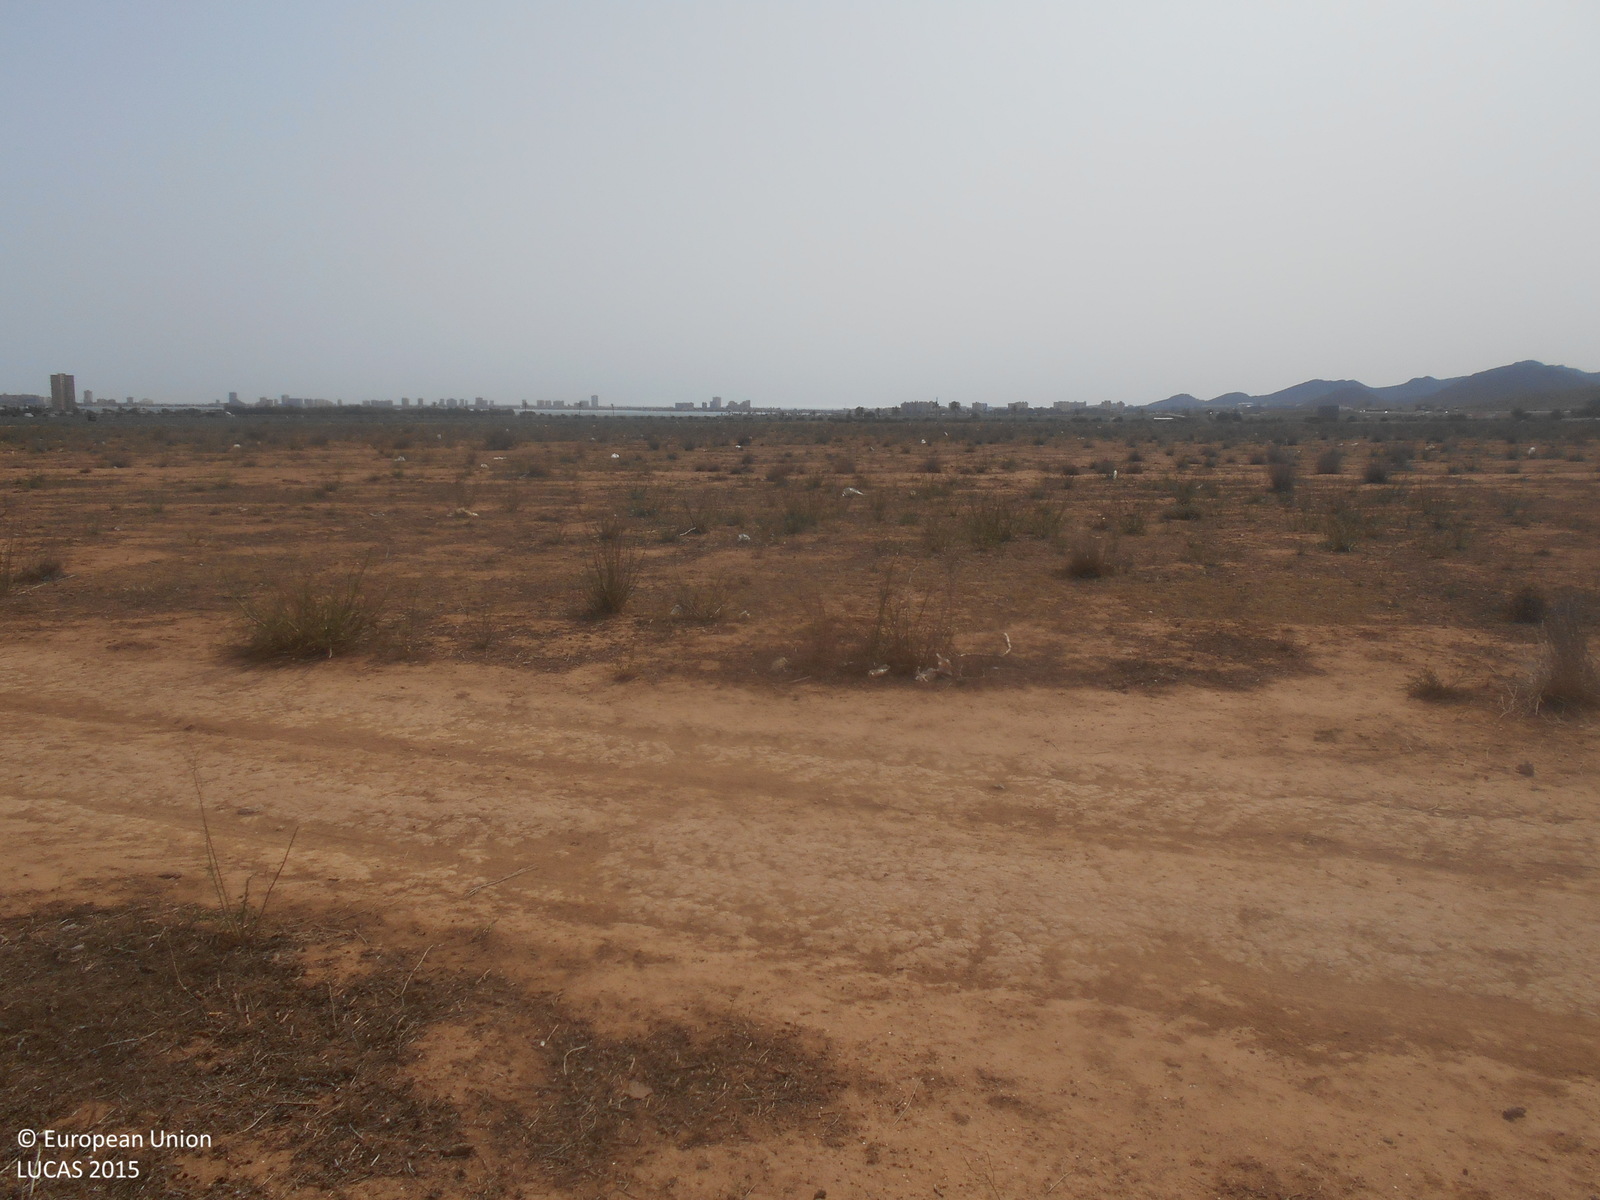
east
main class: Shrubland
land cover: Shrubland without tree cover
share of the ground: 10 - 25 %
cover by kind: unconsolidated bare surface 80 %, shrubs 10 %, herbaceous plants 10 %
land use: Semi-natural and natural areas not in use
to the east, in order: Shrubland without tree cover; Tracks; Shrubland without tree cover; Other bare soil; Shrubland without tree cover
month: May
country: ES
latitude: 37.6269
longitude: -0.7762
